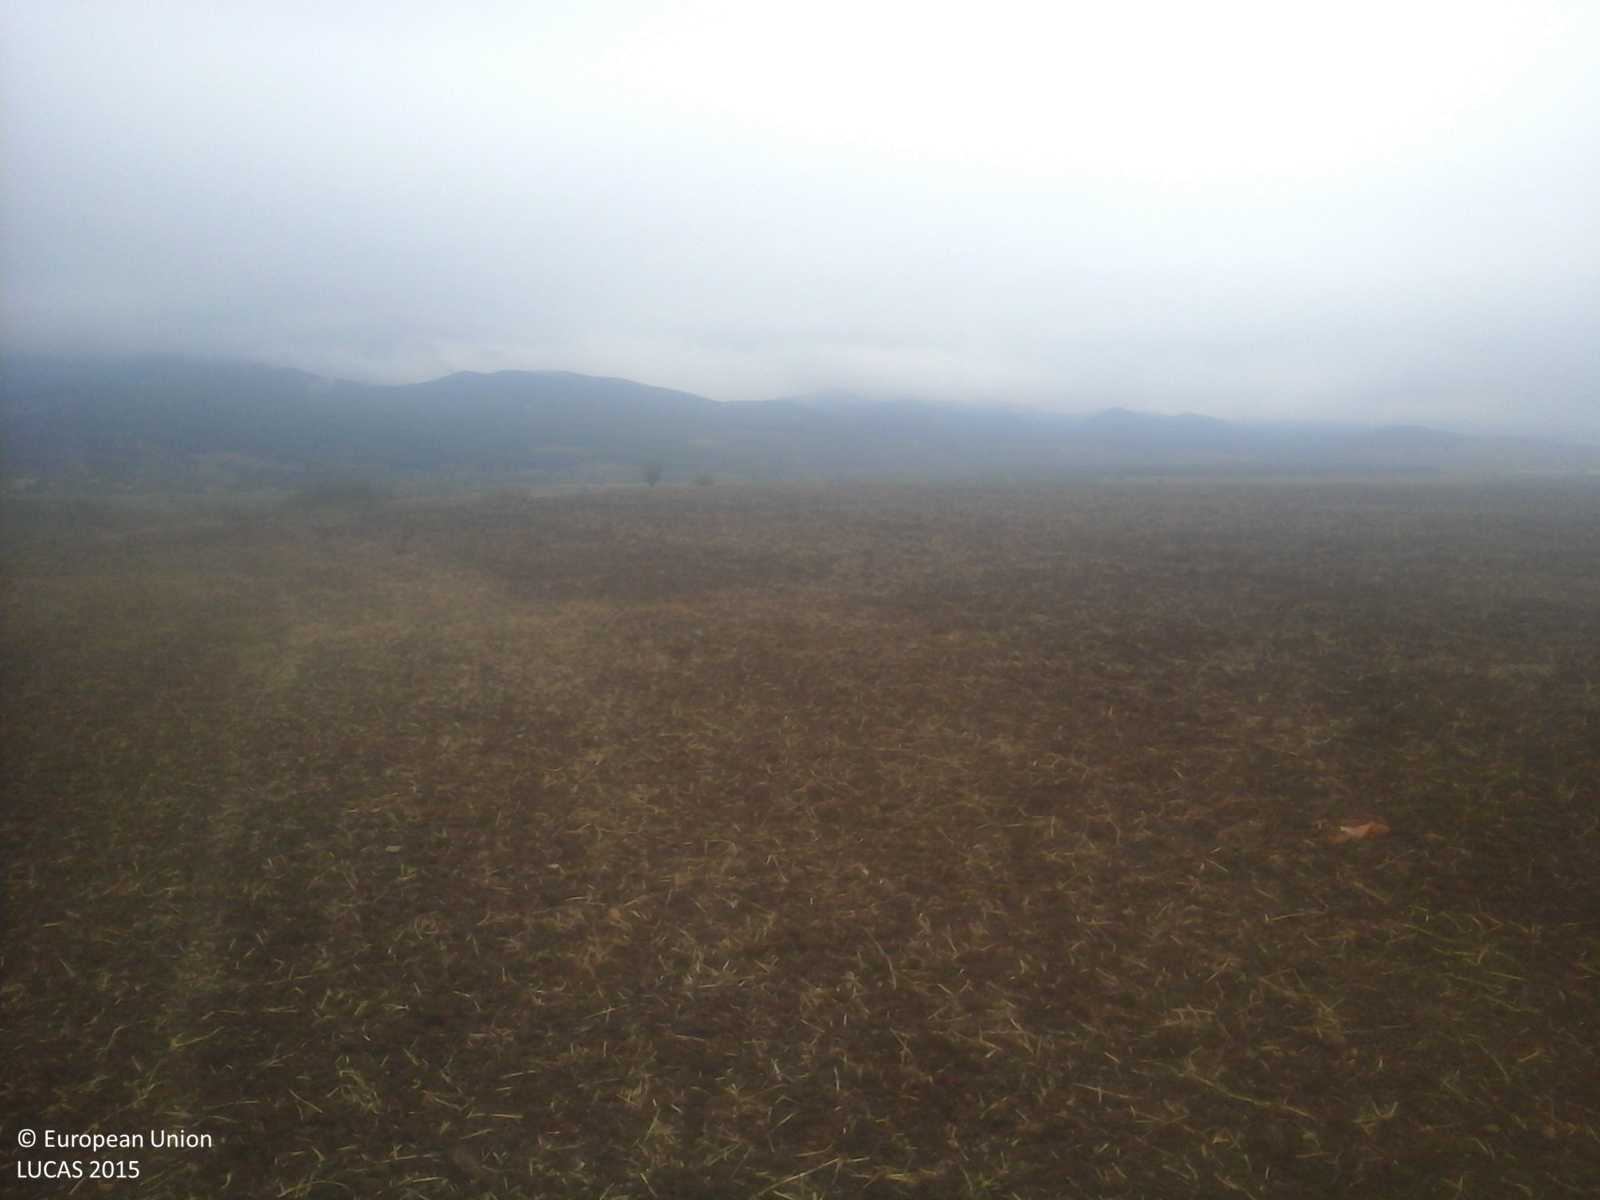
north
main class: Cropland
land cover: Common wheat
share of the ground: < 10 %
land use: Agriculture (excluding fallow land and kitchen gardens)
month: September
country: RO
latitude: 45.9399
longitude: 23.4125
